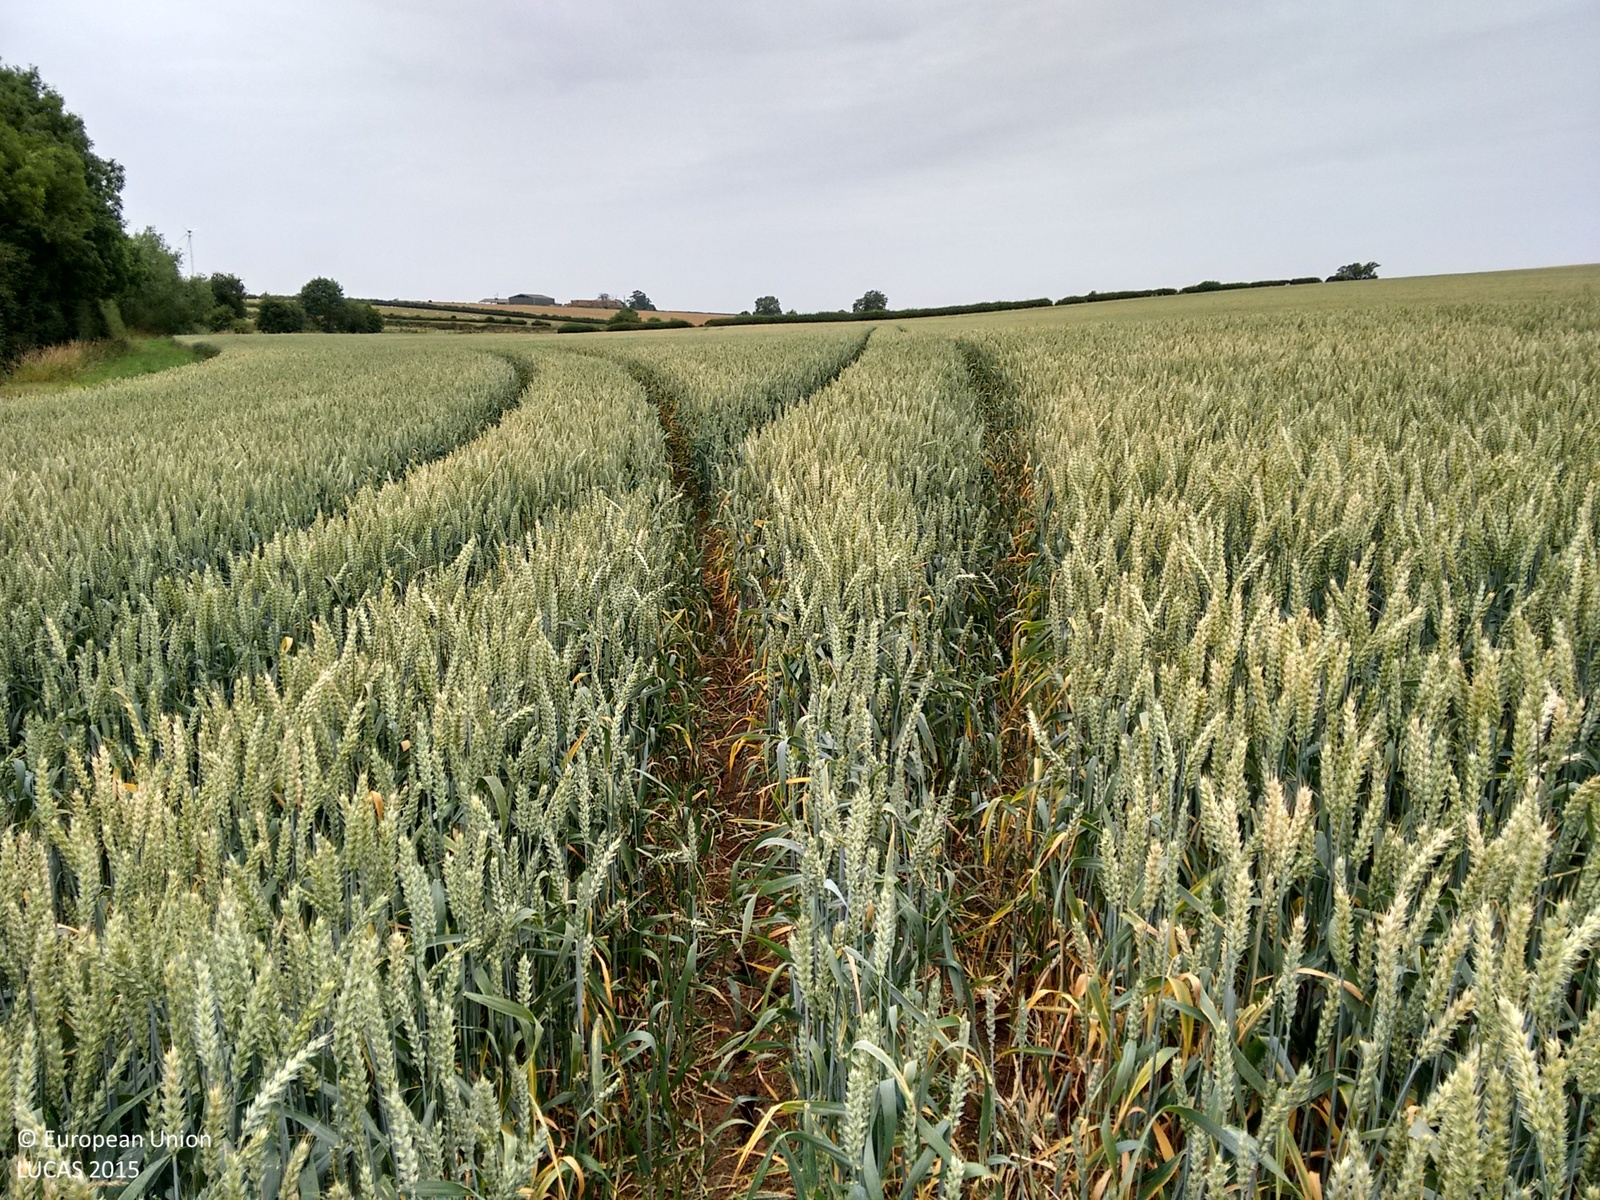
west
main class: Cropland
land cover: Common wheat
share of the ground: > 75 %
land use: Agriculture (excluding fallow land and kitchen gardens)
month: July
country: GB
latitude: 52.7395
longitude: -0.9596
